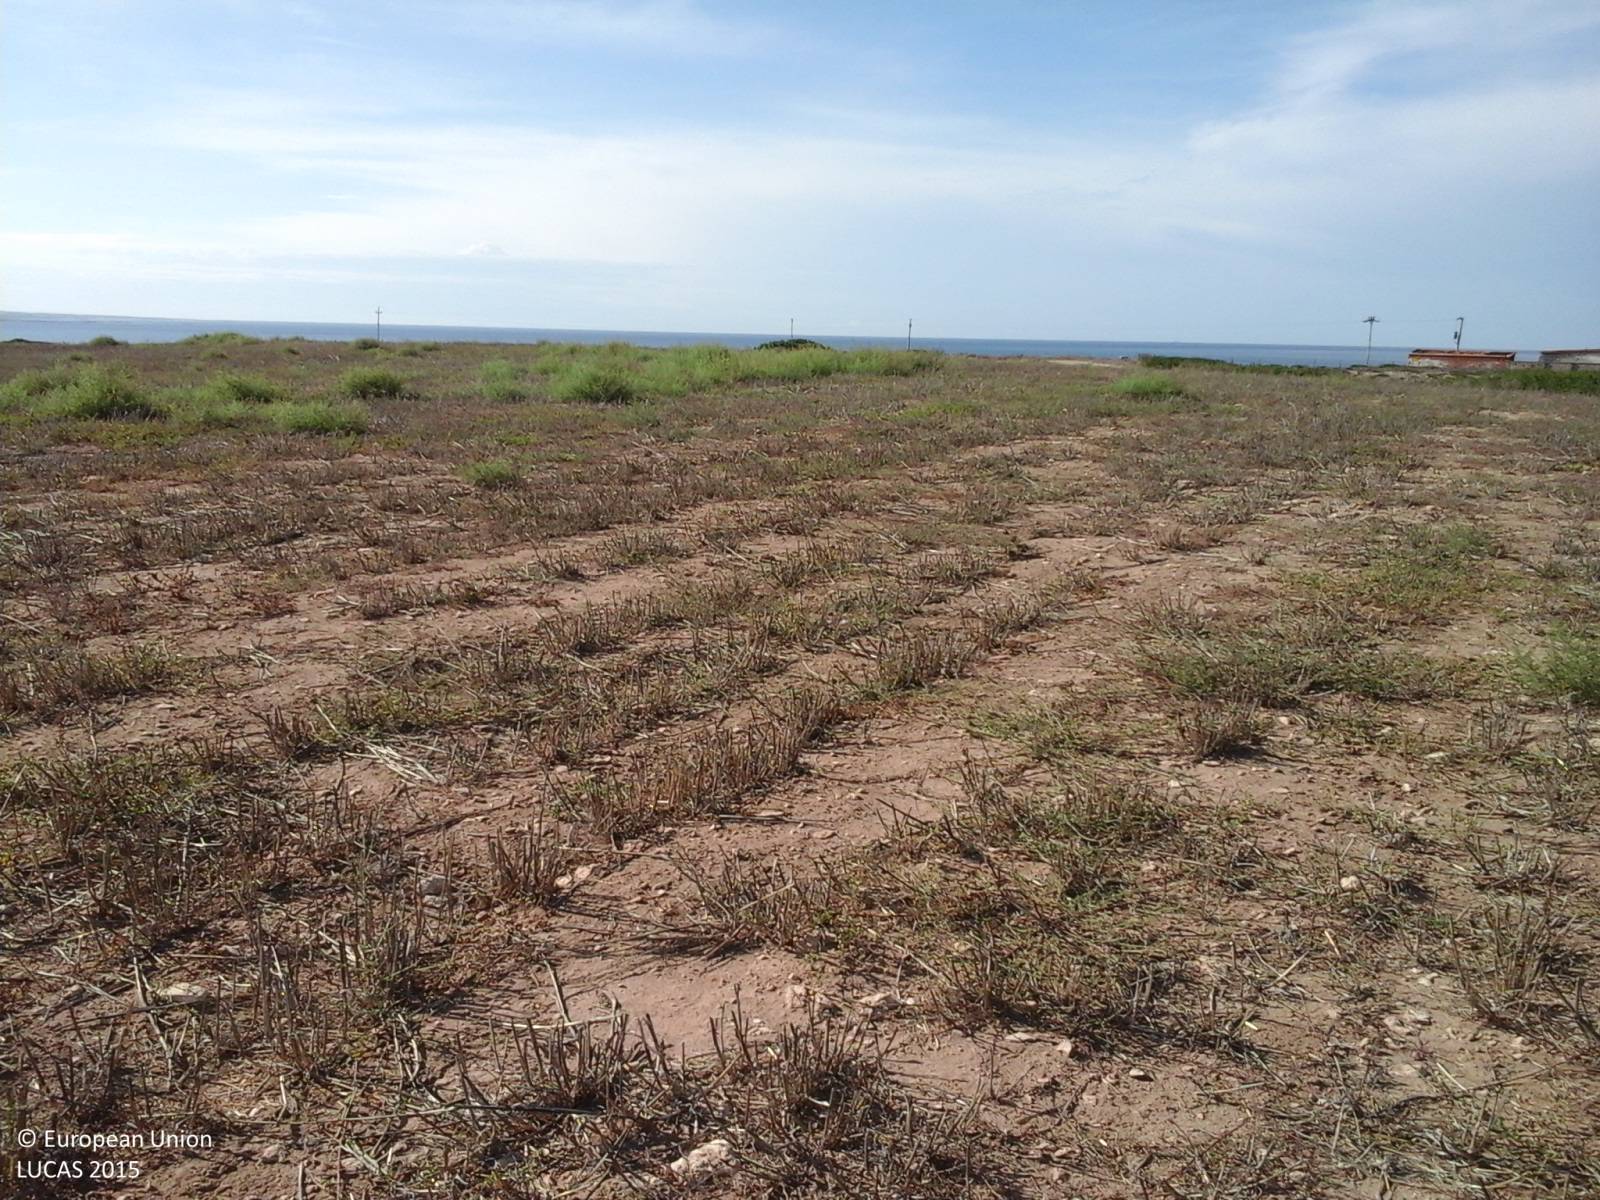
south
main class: Cropland
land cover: Mixed cereals for fodder
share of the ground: 10 - 25 %
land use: Agriculture (excluding fallow land and kitchen gardens)
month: September
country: IT
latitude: 40.0367
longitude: 8.3797
